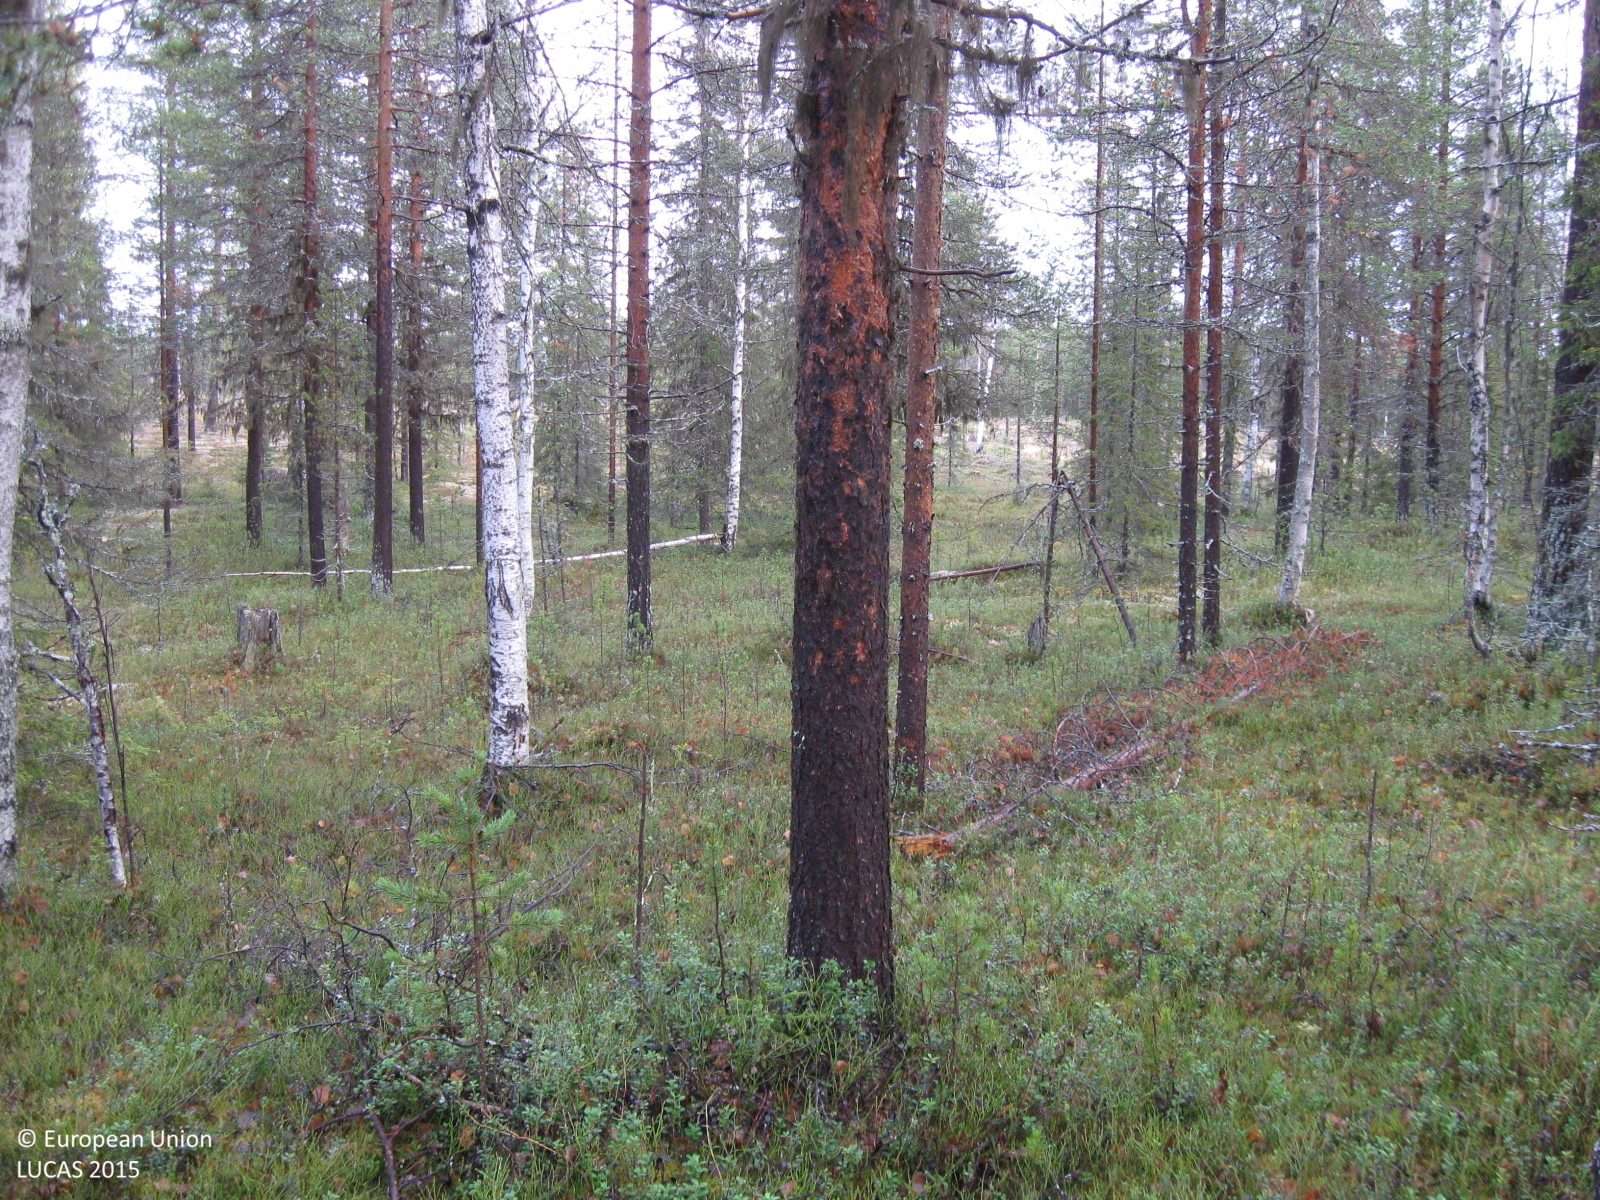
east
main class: Woodland
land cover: Pine dominated coniferous woodland
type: boreal forest
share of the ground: 50 - 75 %
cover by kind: coniferous forest trees 60 %, broadleaved forest trees 15 %, shrubs 10 %, lichens and mosses 10 %, herbaceous plants 5 %
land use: Forestry
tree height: > 5 m
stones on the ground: > 50 %
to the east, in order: Pine dominated coniferous woodland; Other coniferous woodland; Spruce dominated coniferous woodland
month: October
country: SE
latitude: 66.5082
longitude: 20.9068
